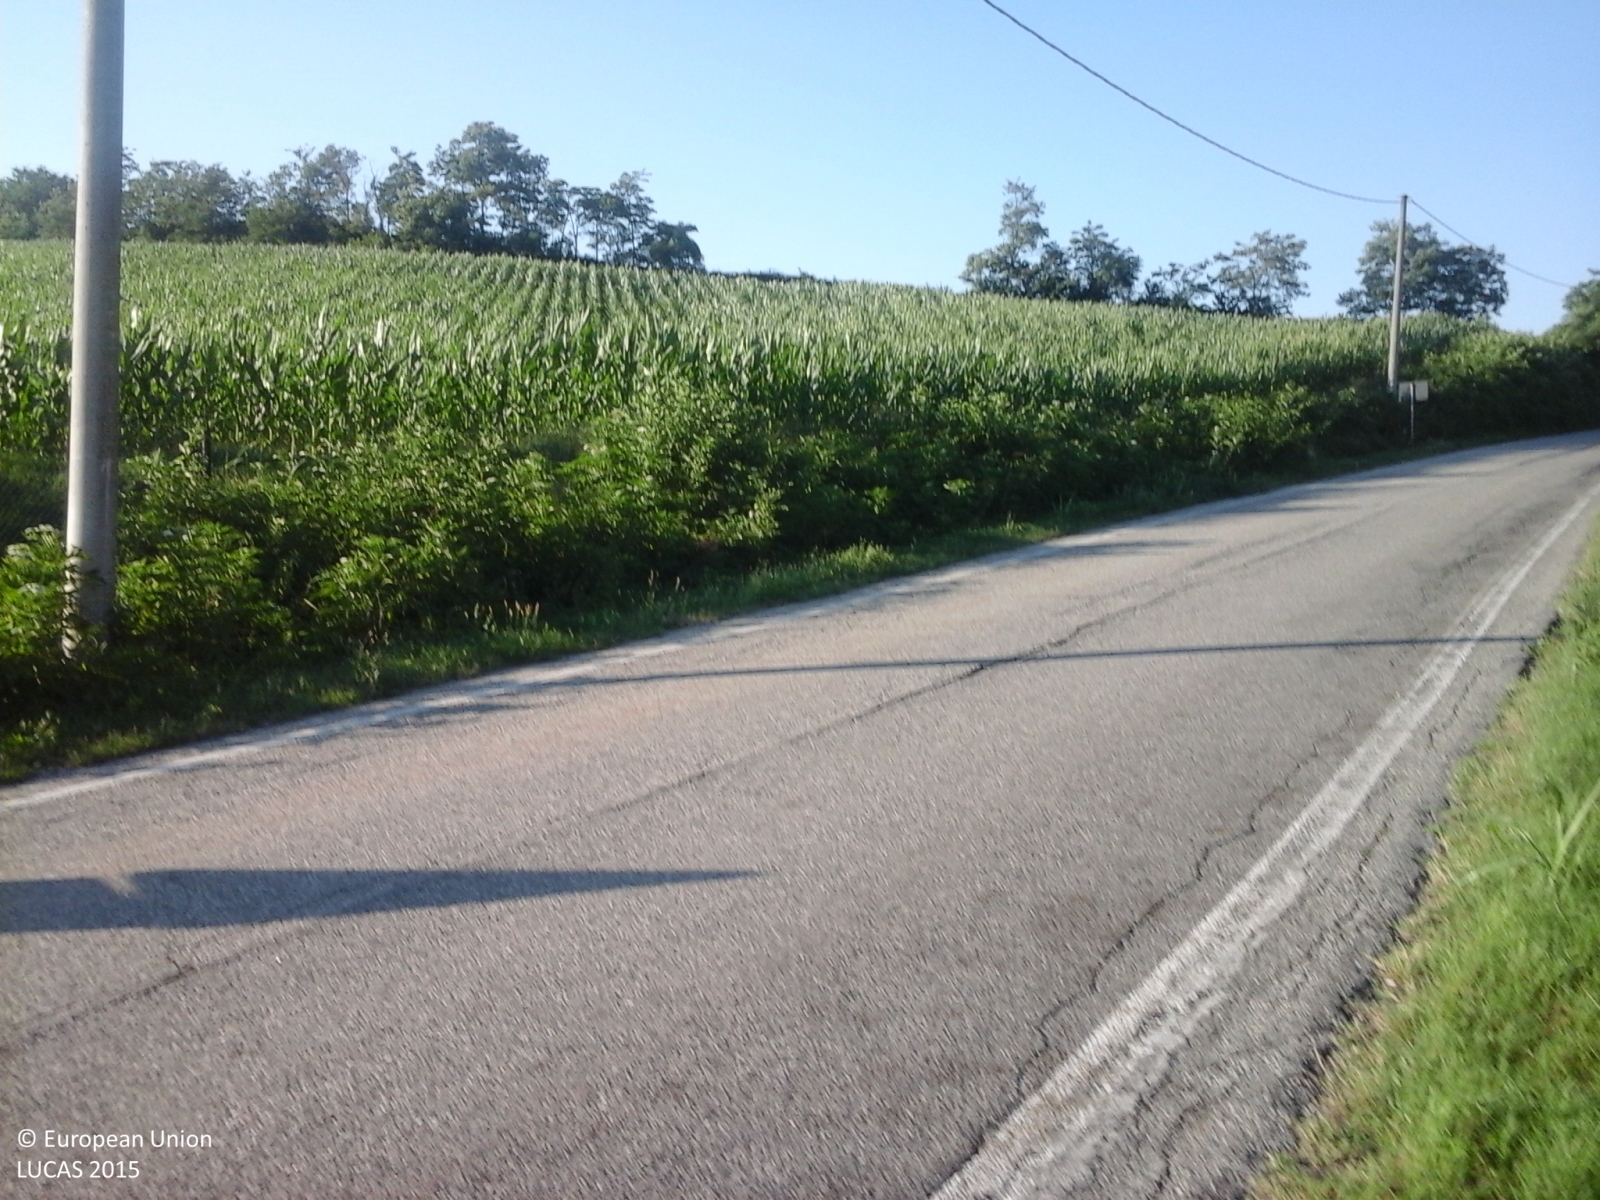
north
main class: Woodland
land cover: Broadleaved woodland
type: thermophilous deciduous forest
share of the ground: > 75 %
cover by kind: broadleaved forest trees 90 %, shrubs 10 %
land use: Semi-natural and natural areas not in use
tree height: > 5 m
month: June
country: IT
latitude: 44.9729
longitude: 8.6459
